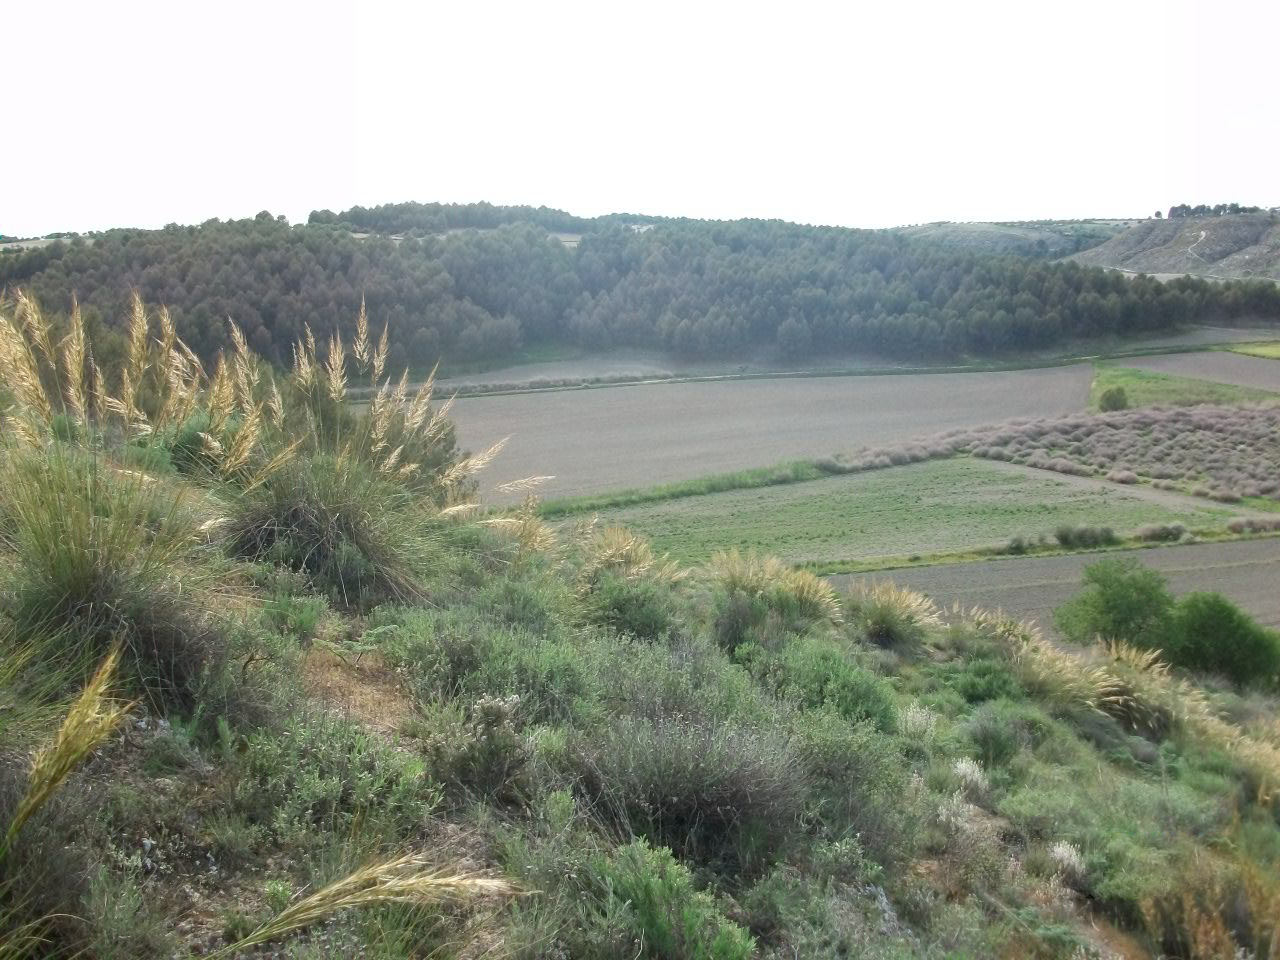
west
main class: Shrubland
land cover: Shrubland without tree cover
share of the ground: 25 - 50 %
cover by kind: shrubs 45 %, herbaceous plants 45 %, unconsolidated bare surface 10 %
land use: Semi-natural and natural areas not in use
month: May
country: ES
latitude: 40.0474
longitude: -3.7354
